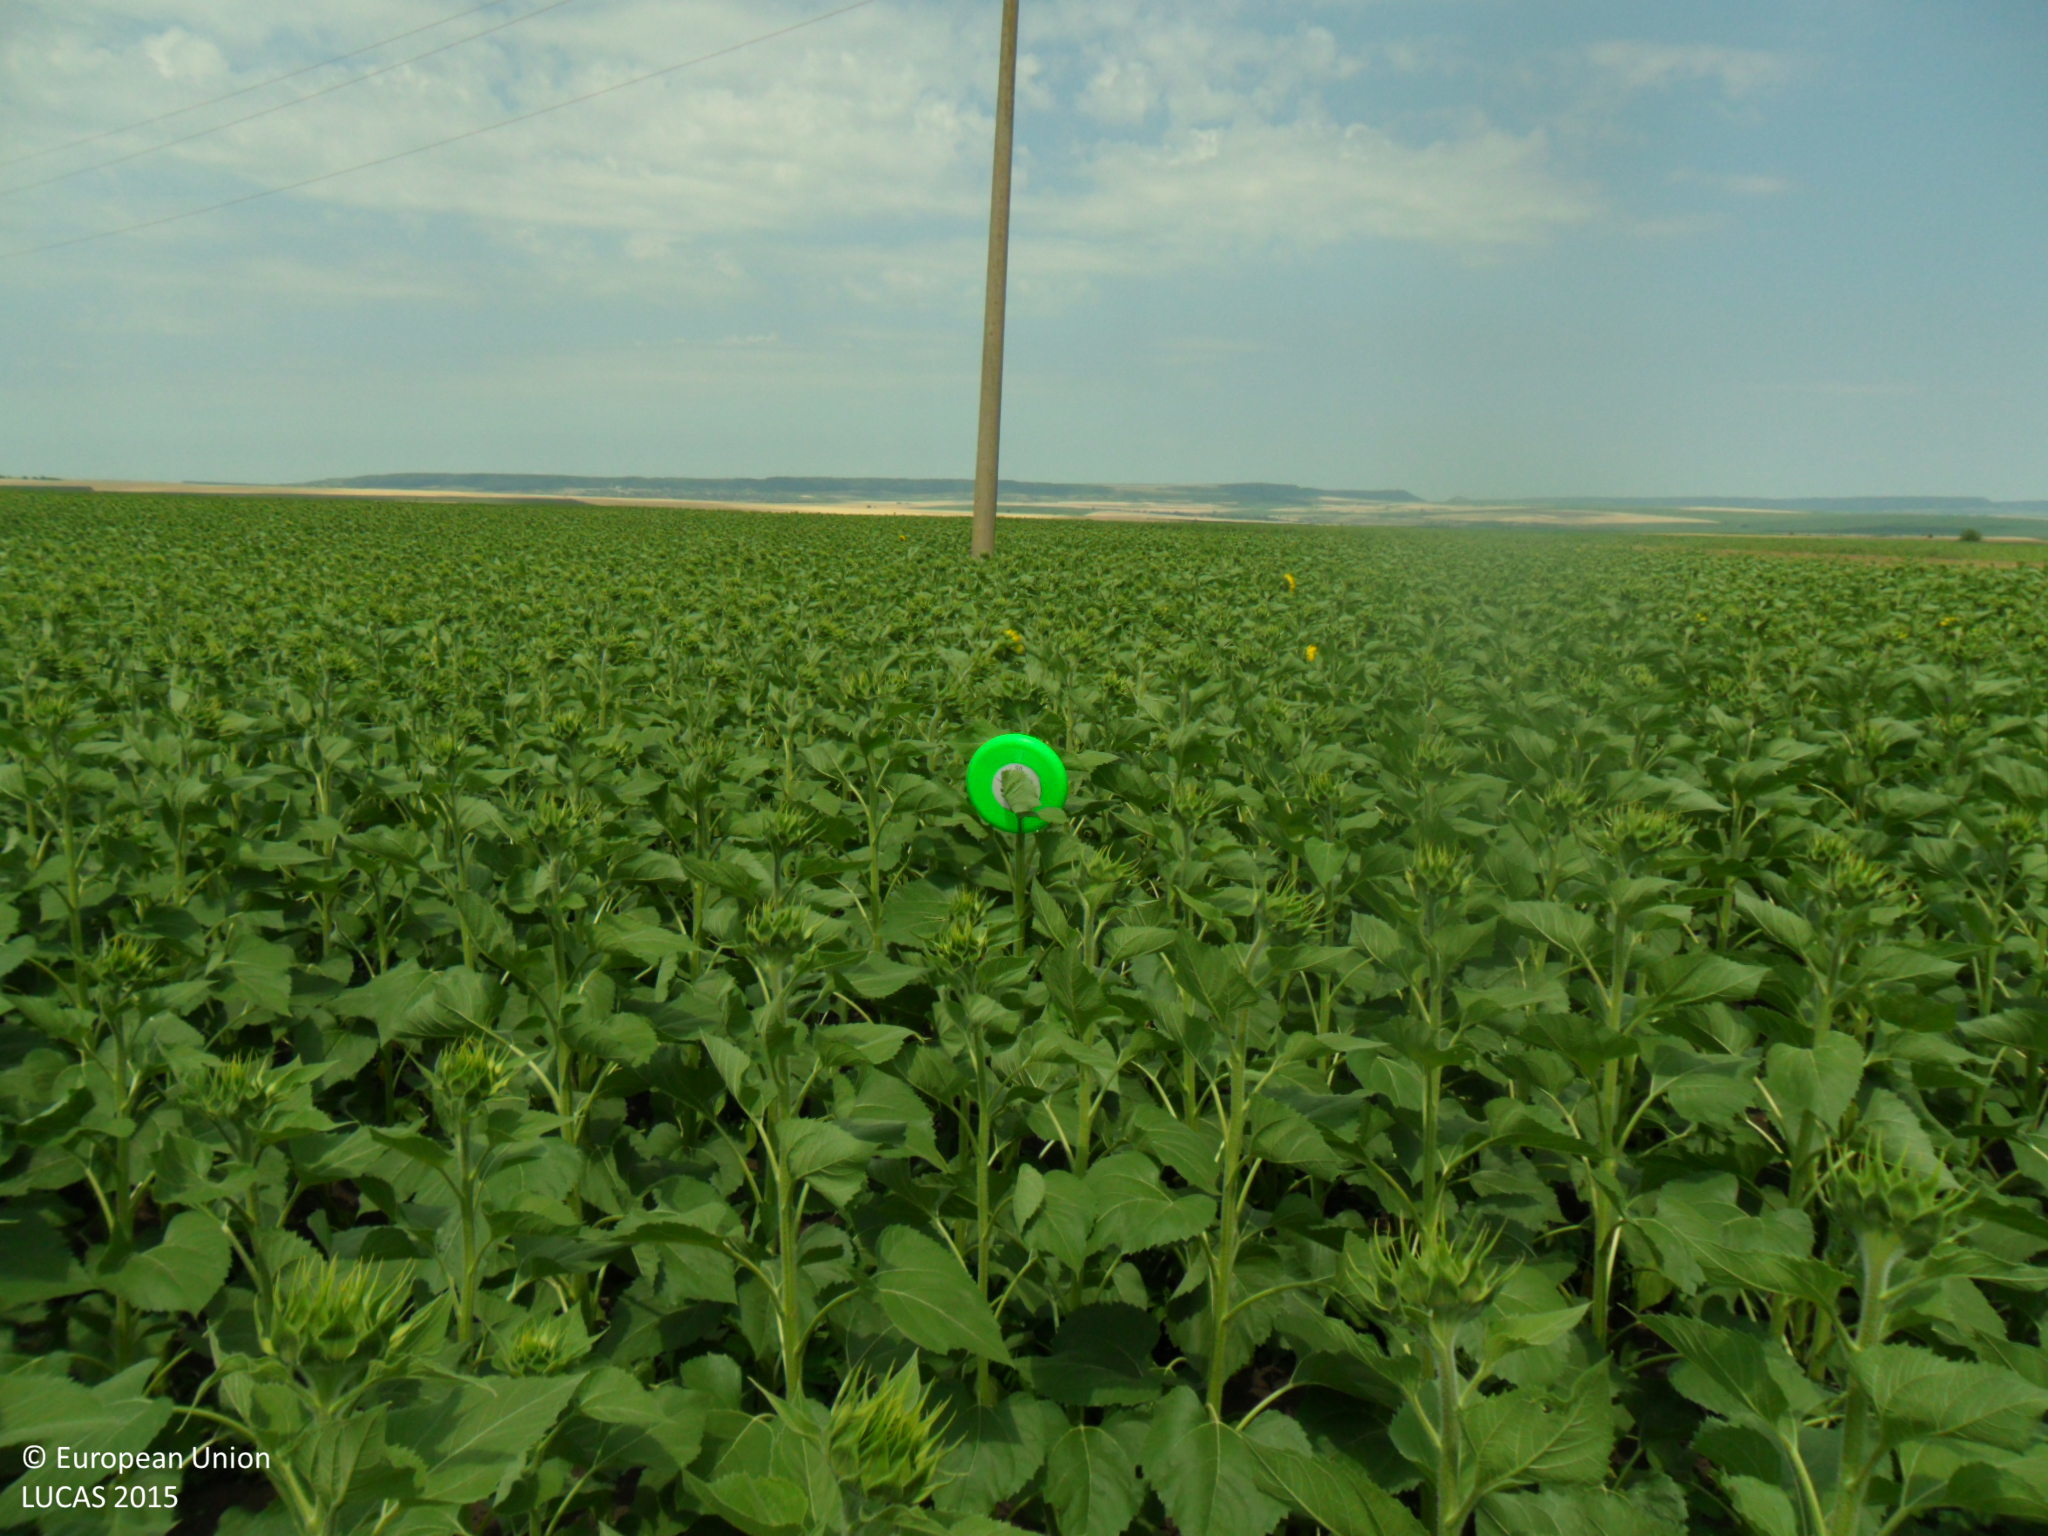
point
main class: Cropland
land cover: Sunflower
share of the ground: > 75 %
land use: Agriculture (excluding fallow land and kitchen gardens)
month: June
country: BG
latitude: 43.3654
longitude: 26.9589
